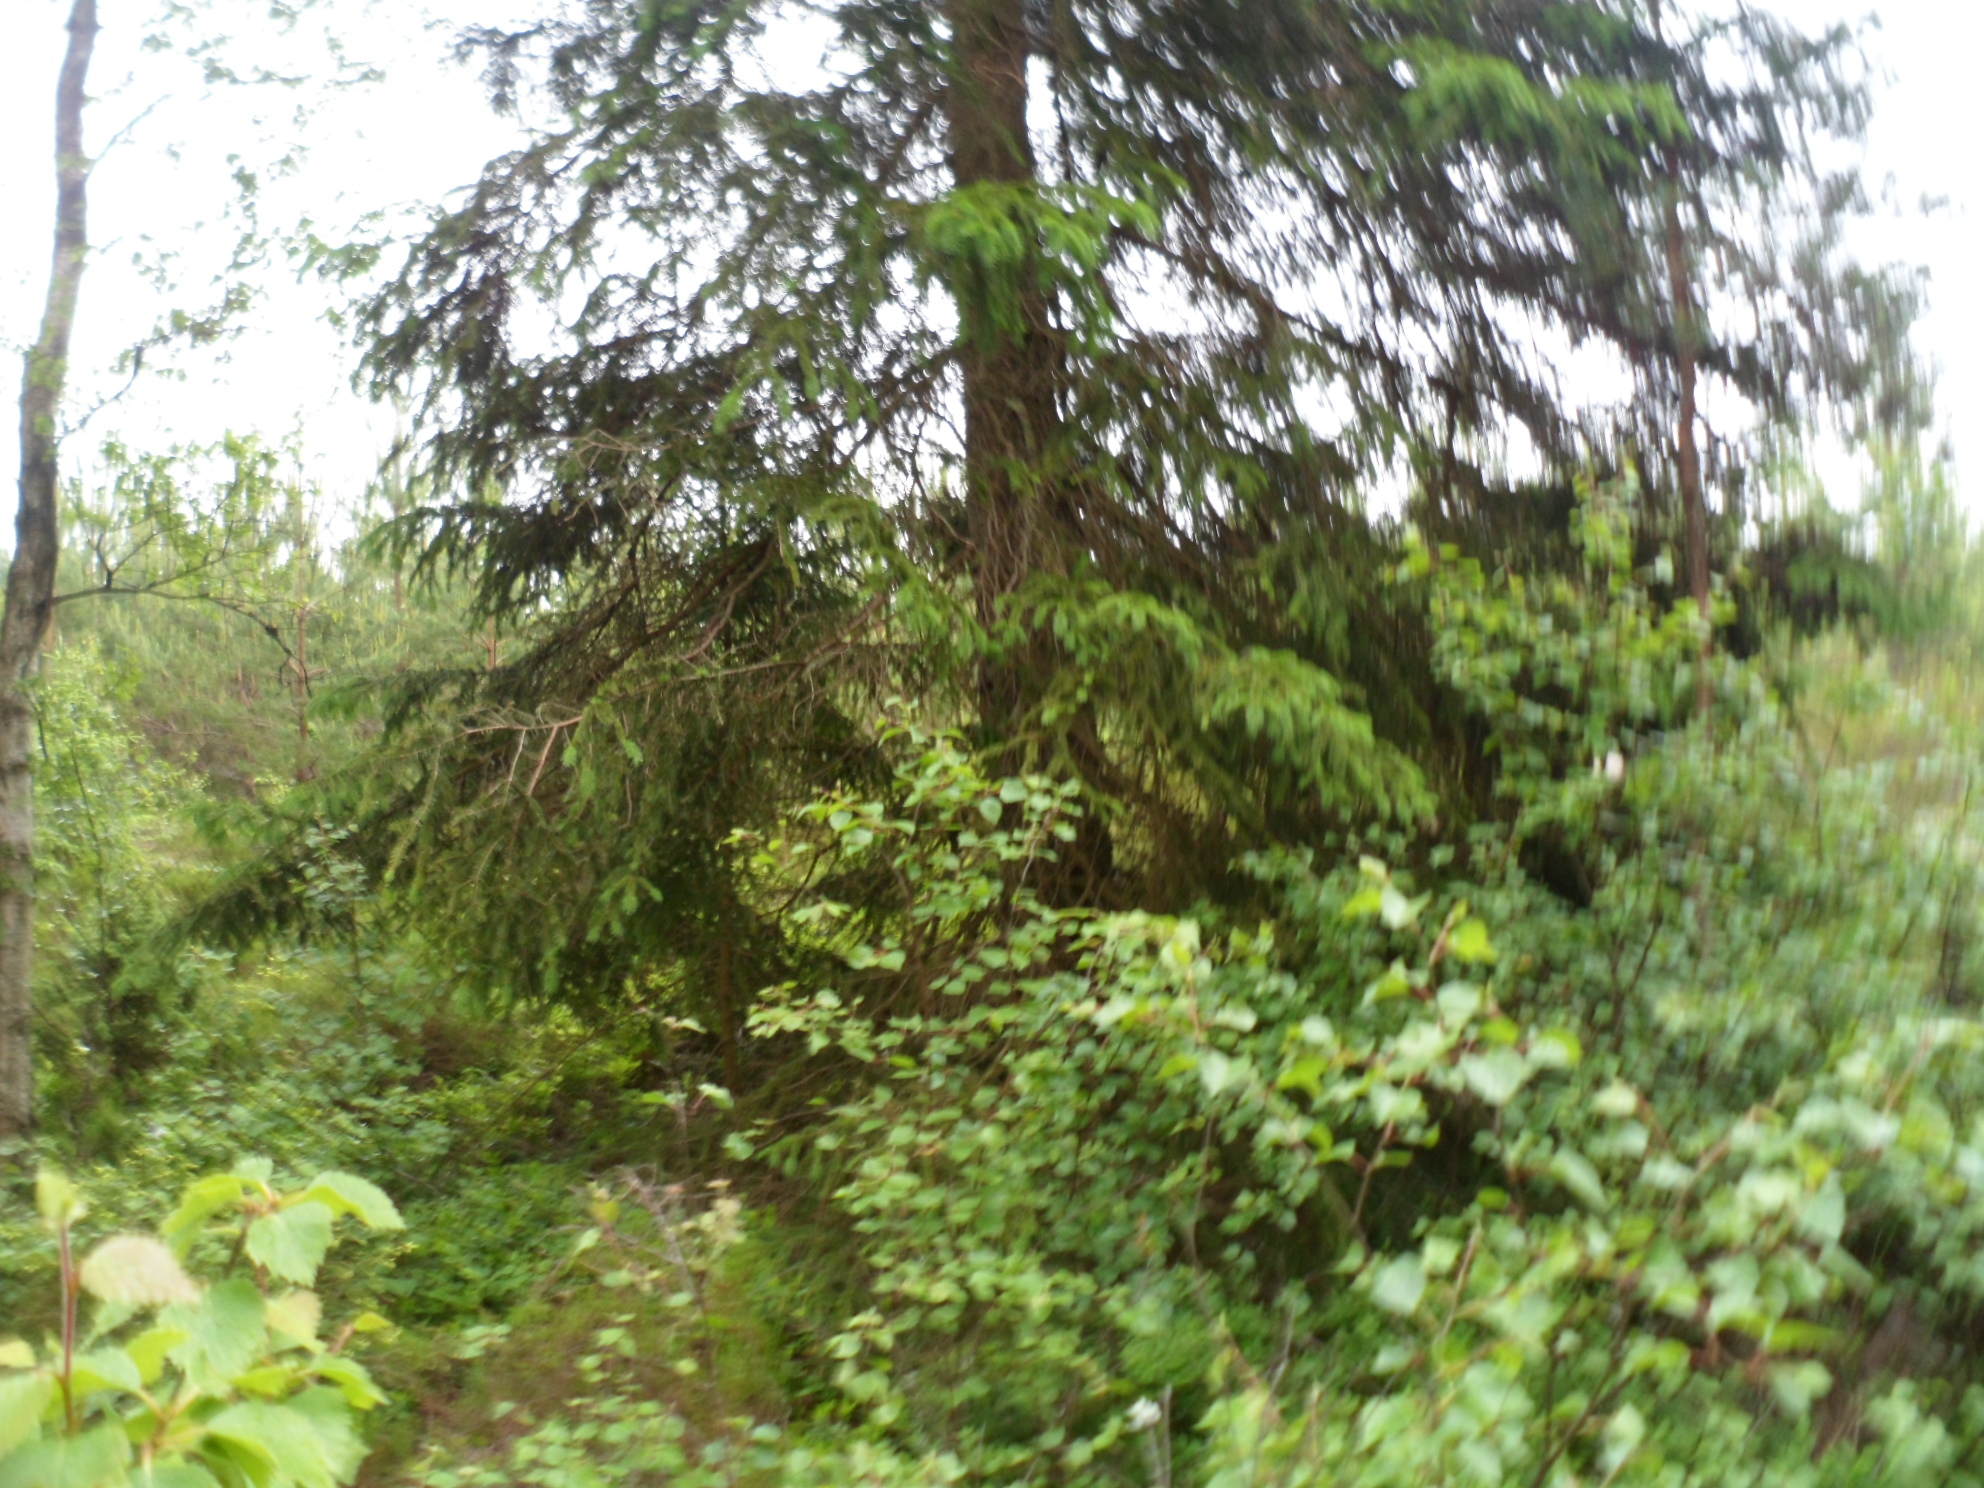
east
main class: Woodland
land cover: Spruce dominated mixed woodland
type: boreal forest
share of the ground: 50 - 75 %
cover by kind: coniferous forest trees 30 %, broadleaved forest trees 30 %, shrubs 20 %, herbaceous plants 10 %, lichens and mosses 10 %
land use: Forestry
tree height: > 5 m
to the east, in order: Ditches and canals; Spruce dominated mixed woodland; Pine dominated coniferous woodland; Spruce dominated mixed woodland; Spruce dominated coniferous woodland; Ditches and canals; Spruce dominated coniferous woodland; Ditches and canals; Spruce dominated coniferous woodland; Pine dominated coniferous woodland
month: June
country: SE
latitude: 57.0506
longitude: 15.3222
